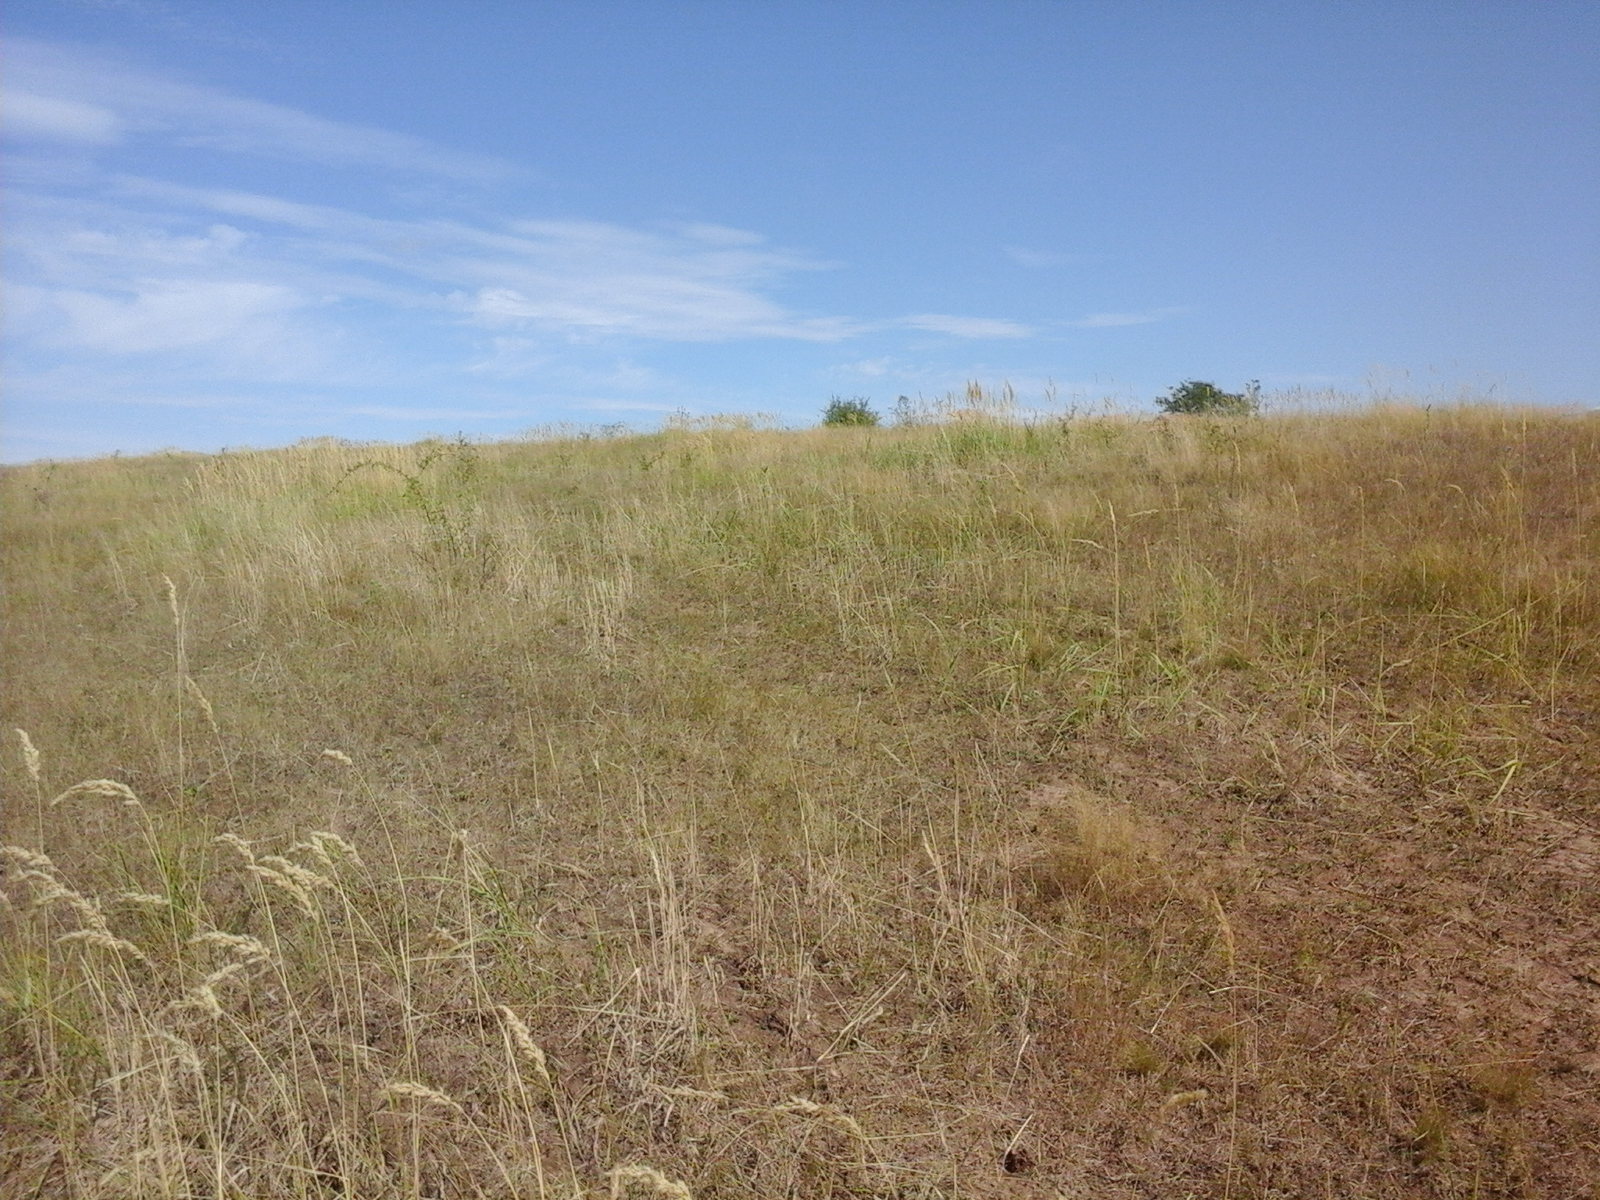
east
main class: Grassland
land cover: Grassland without tree/shrub cover
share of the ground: > 75 %
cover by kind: herbaceous plants 100 %
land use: Agriculture (excluding fallow land and kitchen gardens)
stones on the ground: < 10 %
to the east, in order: Grassland without tree/shrub cover; Tracks; Grassland without tree/shrub cover; Tracks; Grassland without tree/shrub cover; Other bare soil
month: August
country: RO
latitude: 45.2422
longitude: 21.4577
